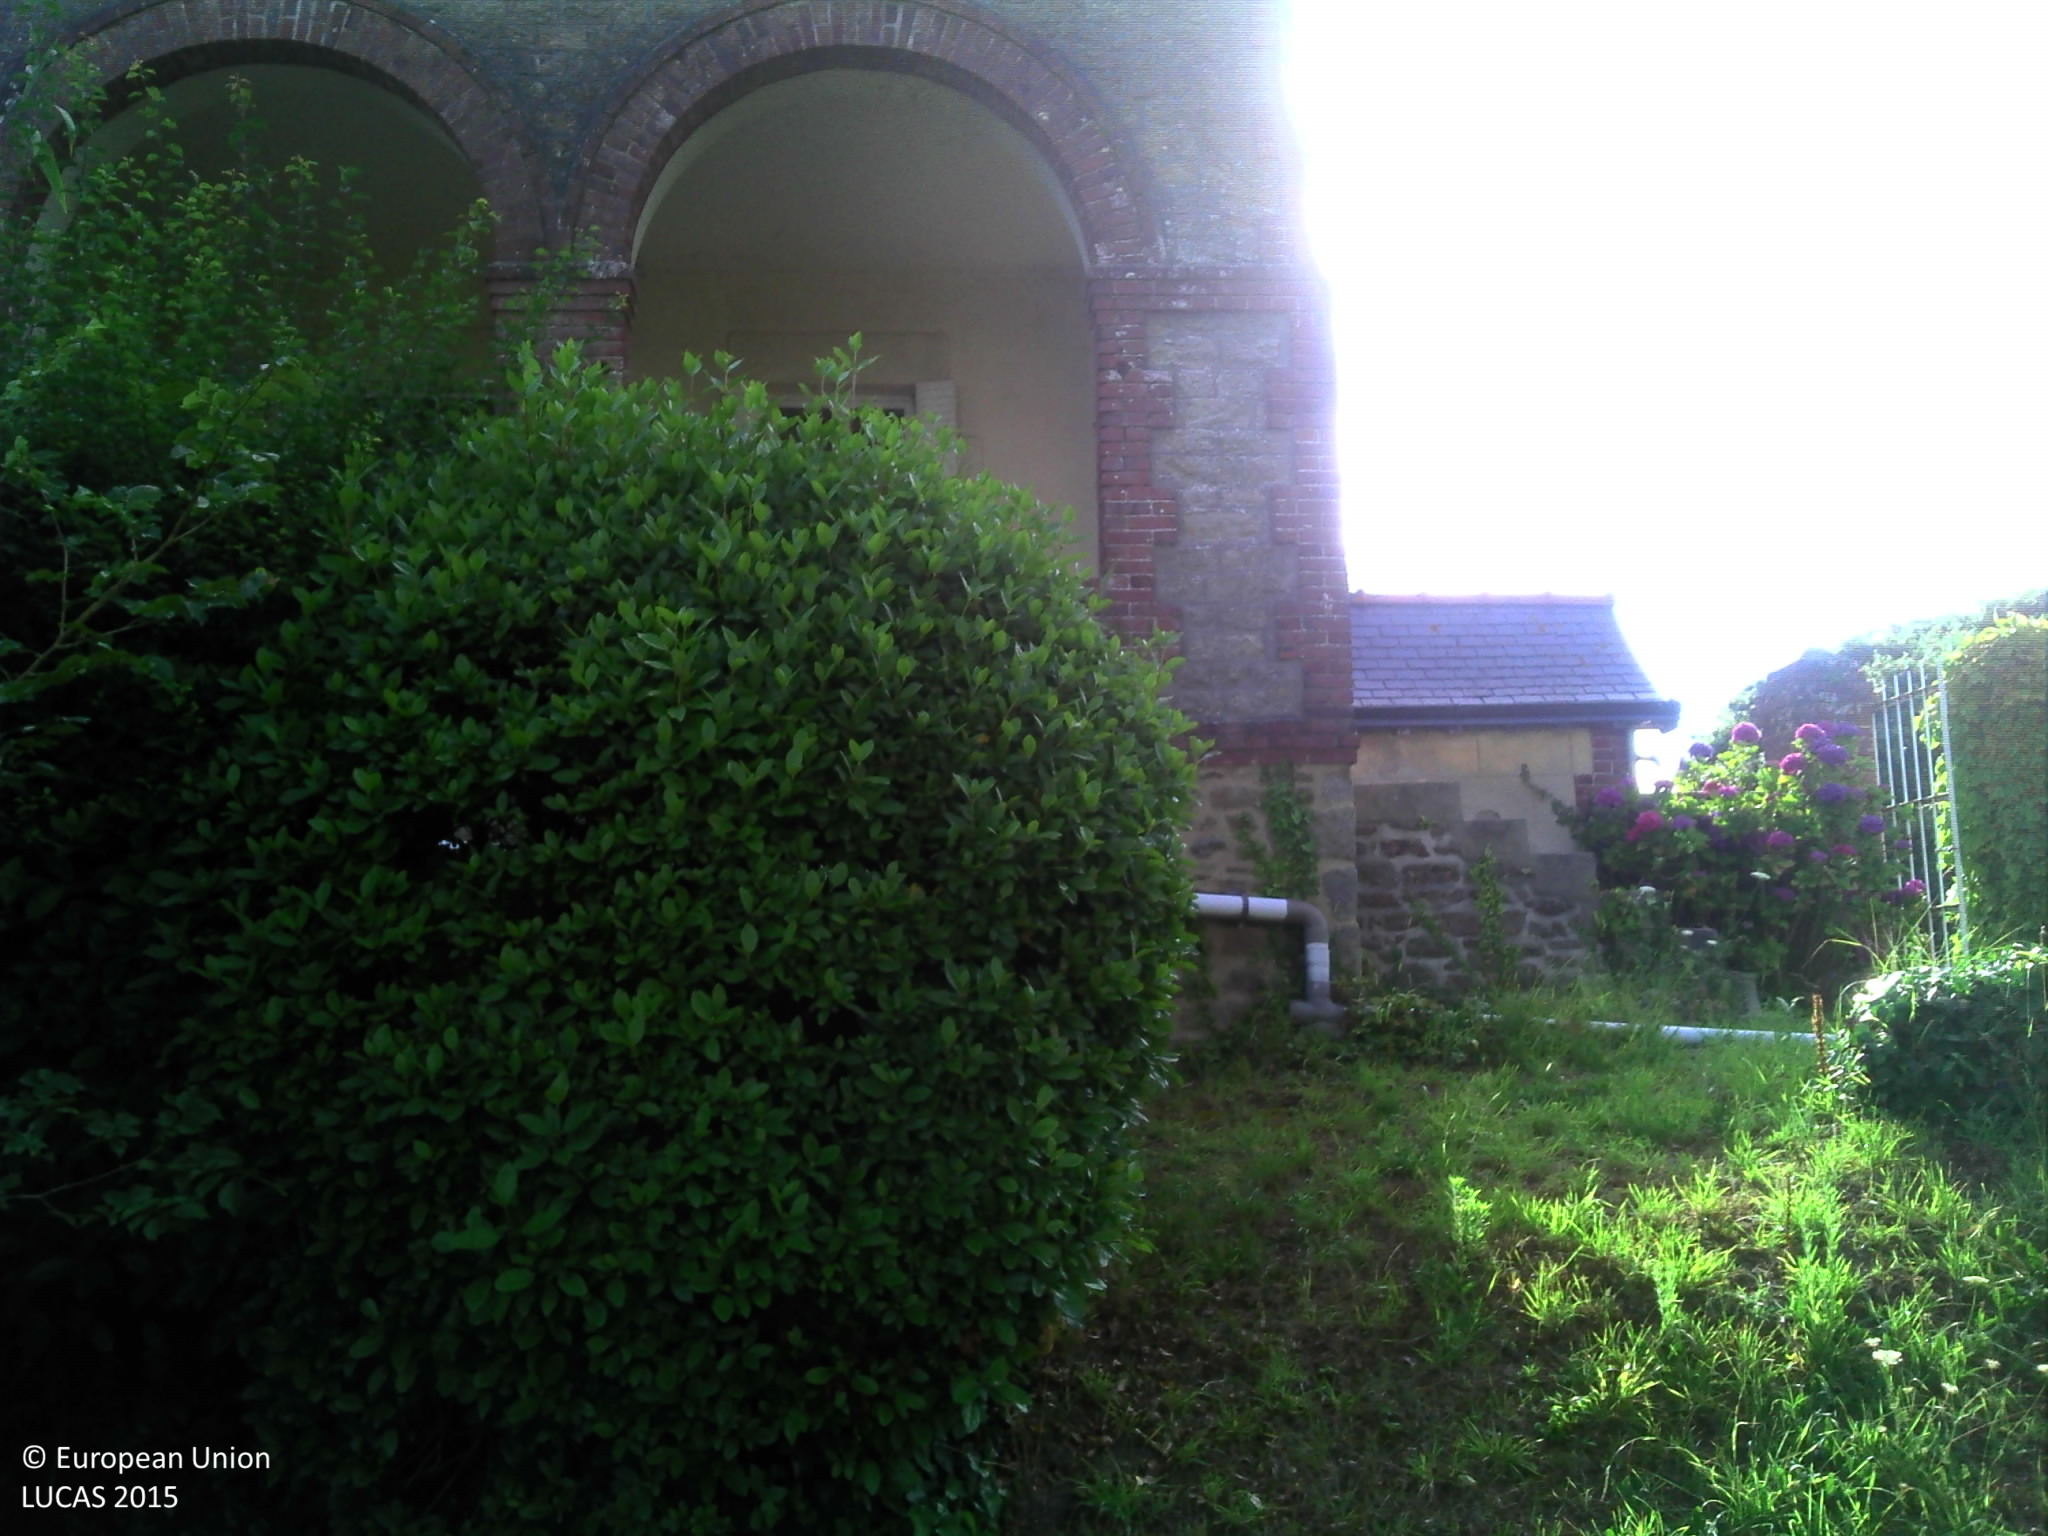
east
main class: Grassland
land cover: Grassland with sparse tree/shrub cover
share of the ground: > 75 %
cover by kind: herbaceous plants 65 %, consolidated bare surface 30 %, coniferous forest trees 5 %
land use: Residential
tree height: > 5 m
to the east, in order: Grassland with sparse tree/shrub cover; Artificial constructions in urban areas
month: July
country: FR
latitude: 48.5990
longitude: -2.1936
